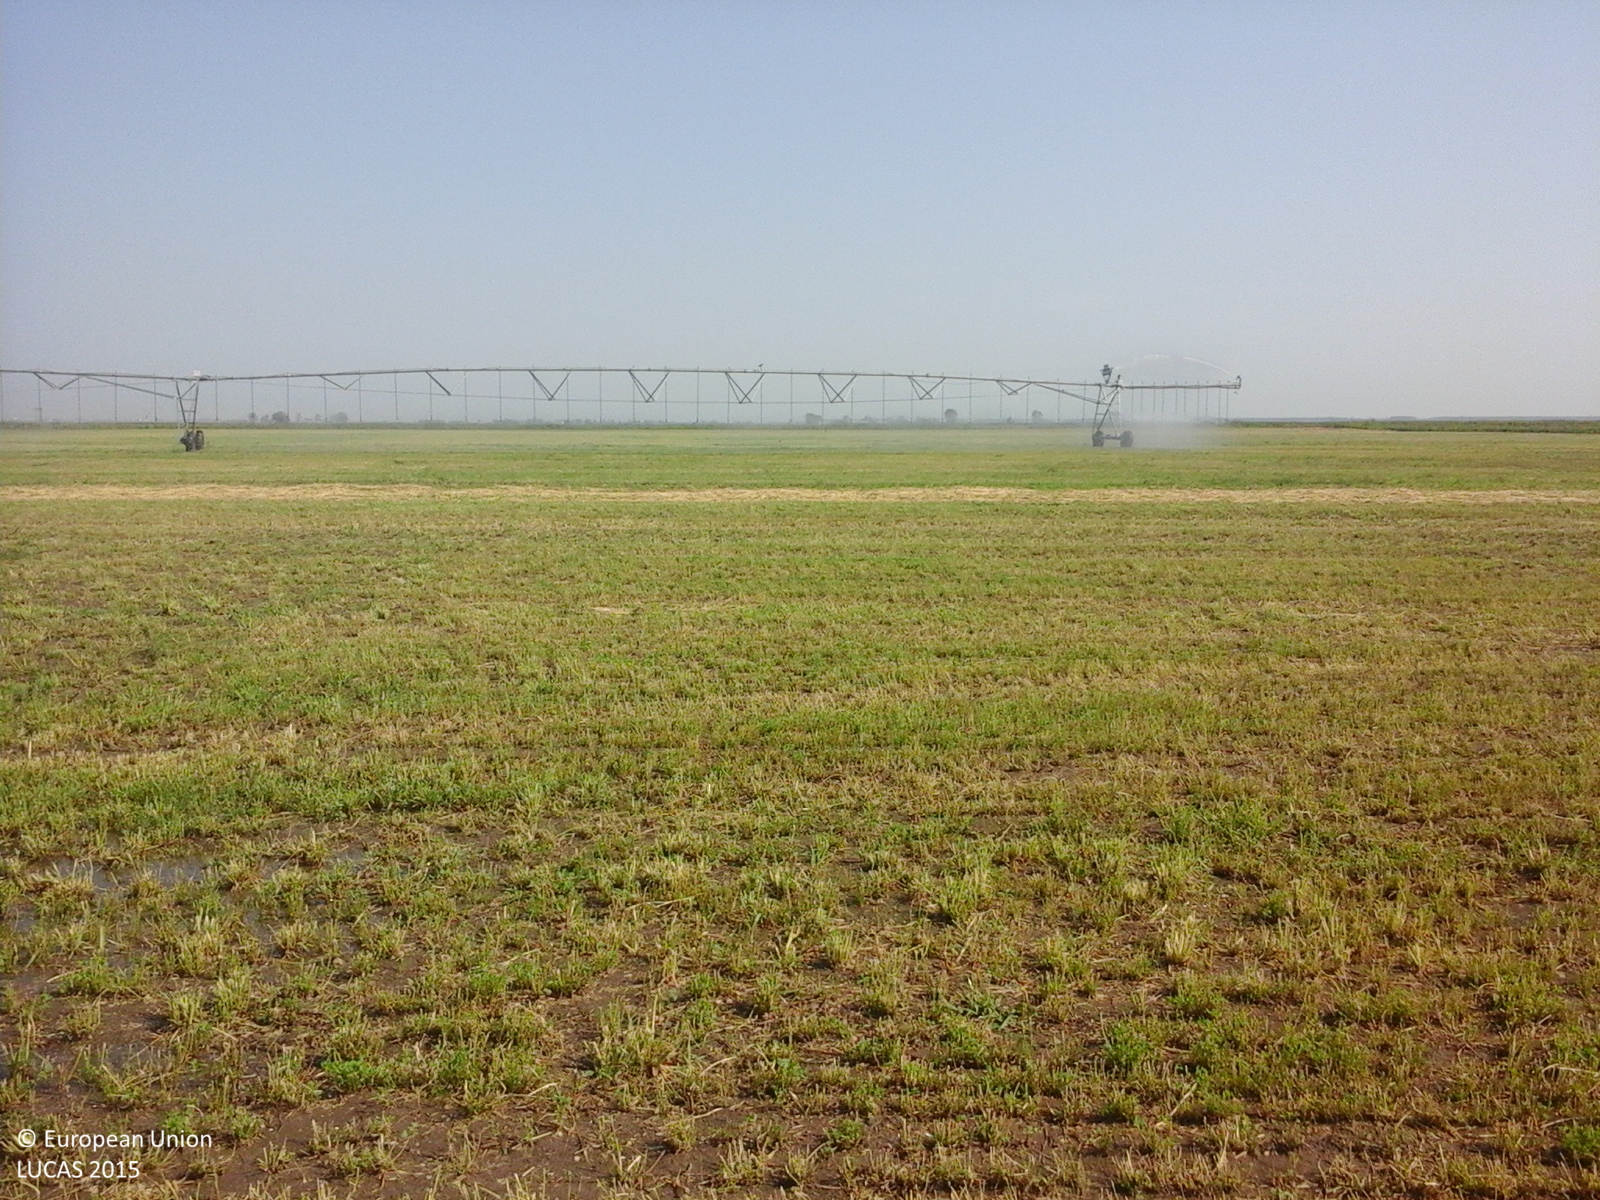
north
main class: Cropland
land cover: Lucerne
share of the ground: 25 - 50 %
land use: Agriculture (excluding fallow land and kitchen gardens)
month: August
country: RO
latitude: 45.1908
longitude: 28.0240
